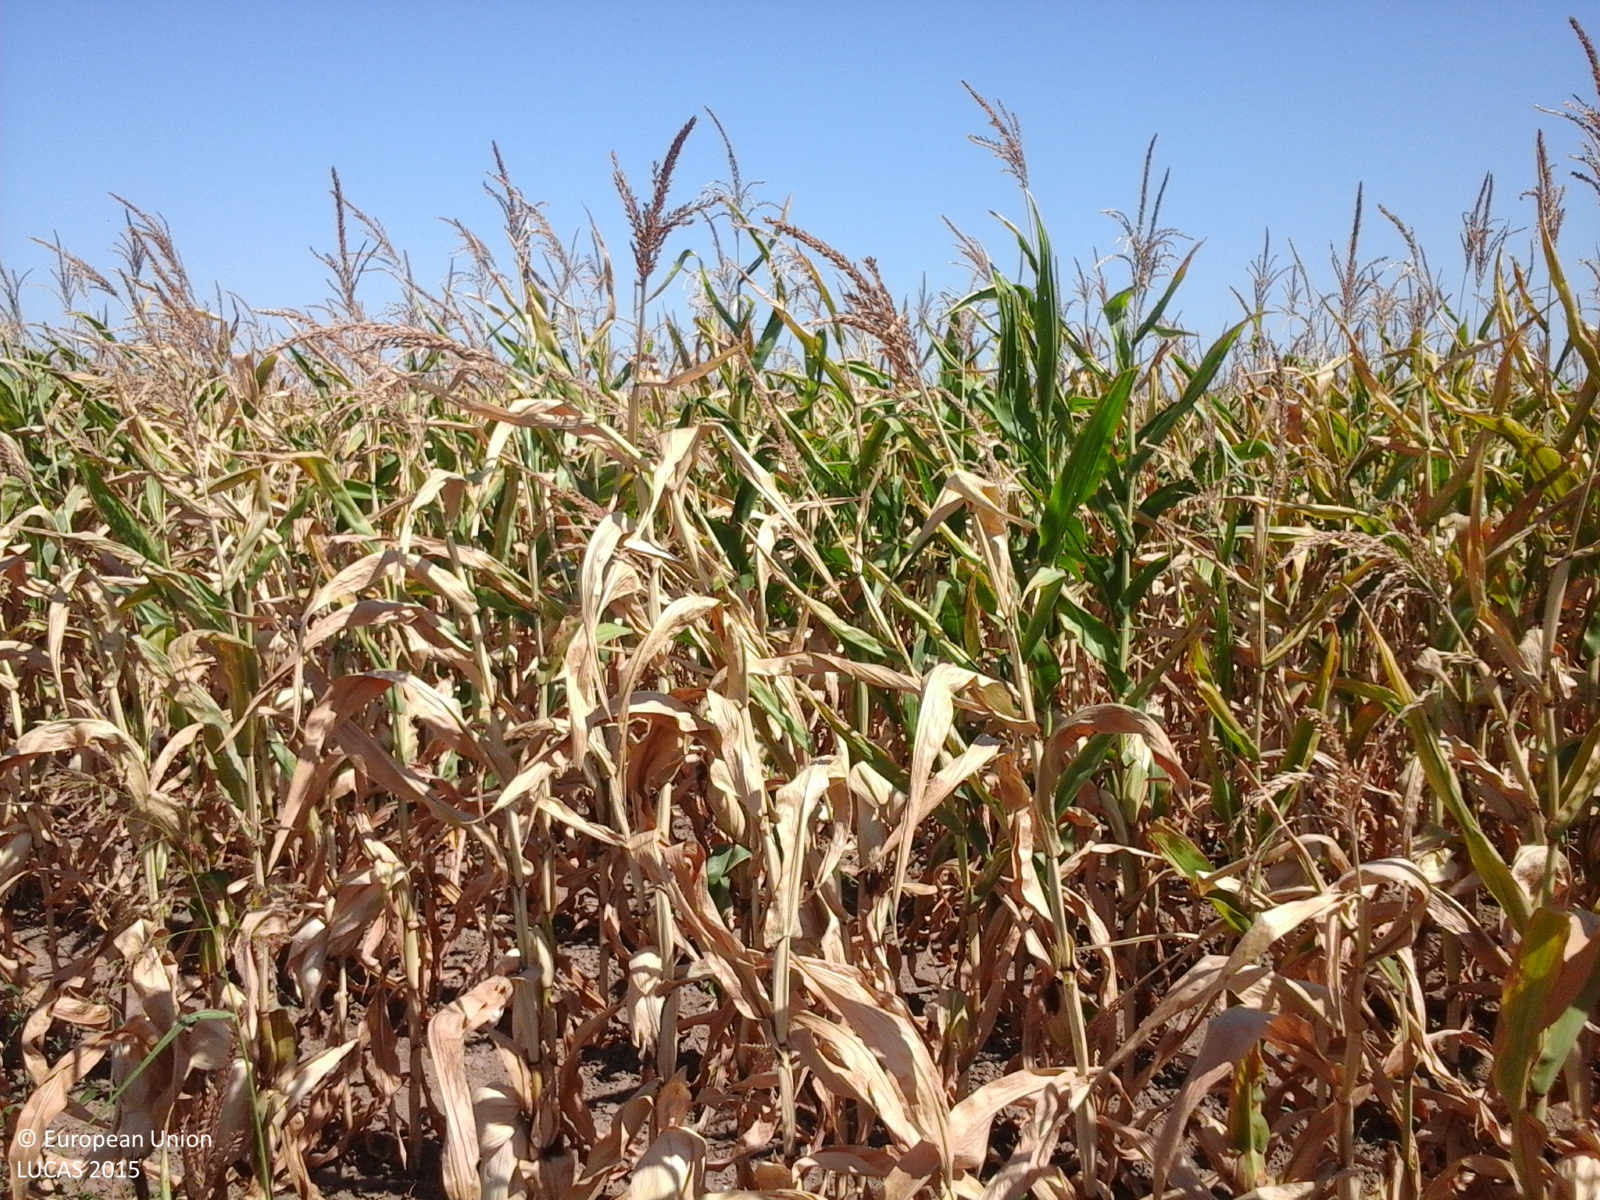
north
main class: Cropland
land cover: Maize
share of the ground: > 75 %
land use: Agriculture (excluding fallow land and kitchen gardens)
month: August
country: RO
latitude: 44.6681
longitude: 28.0599
